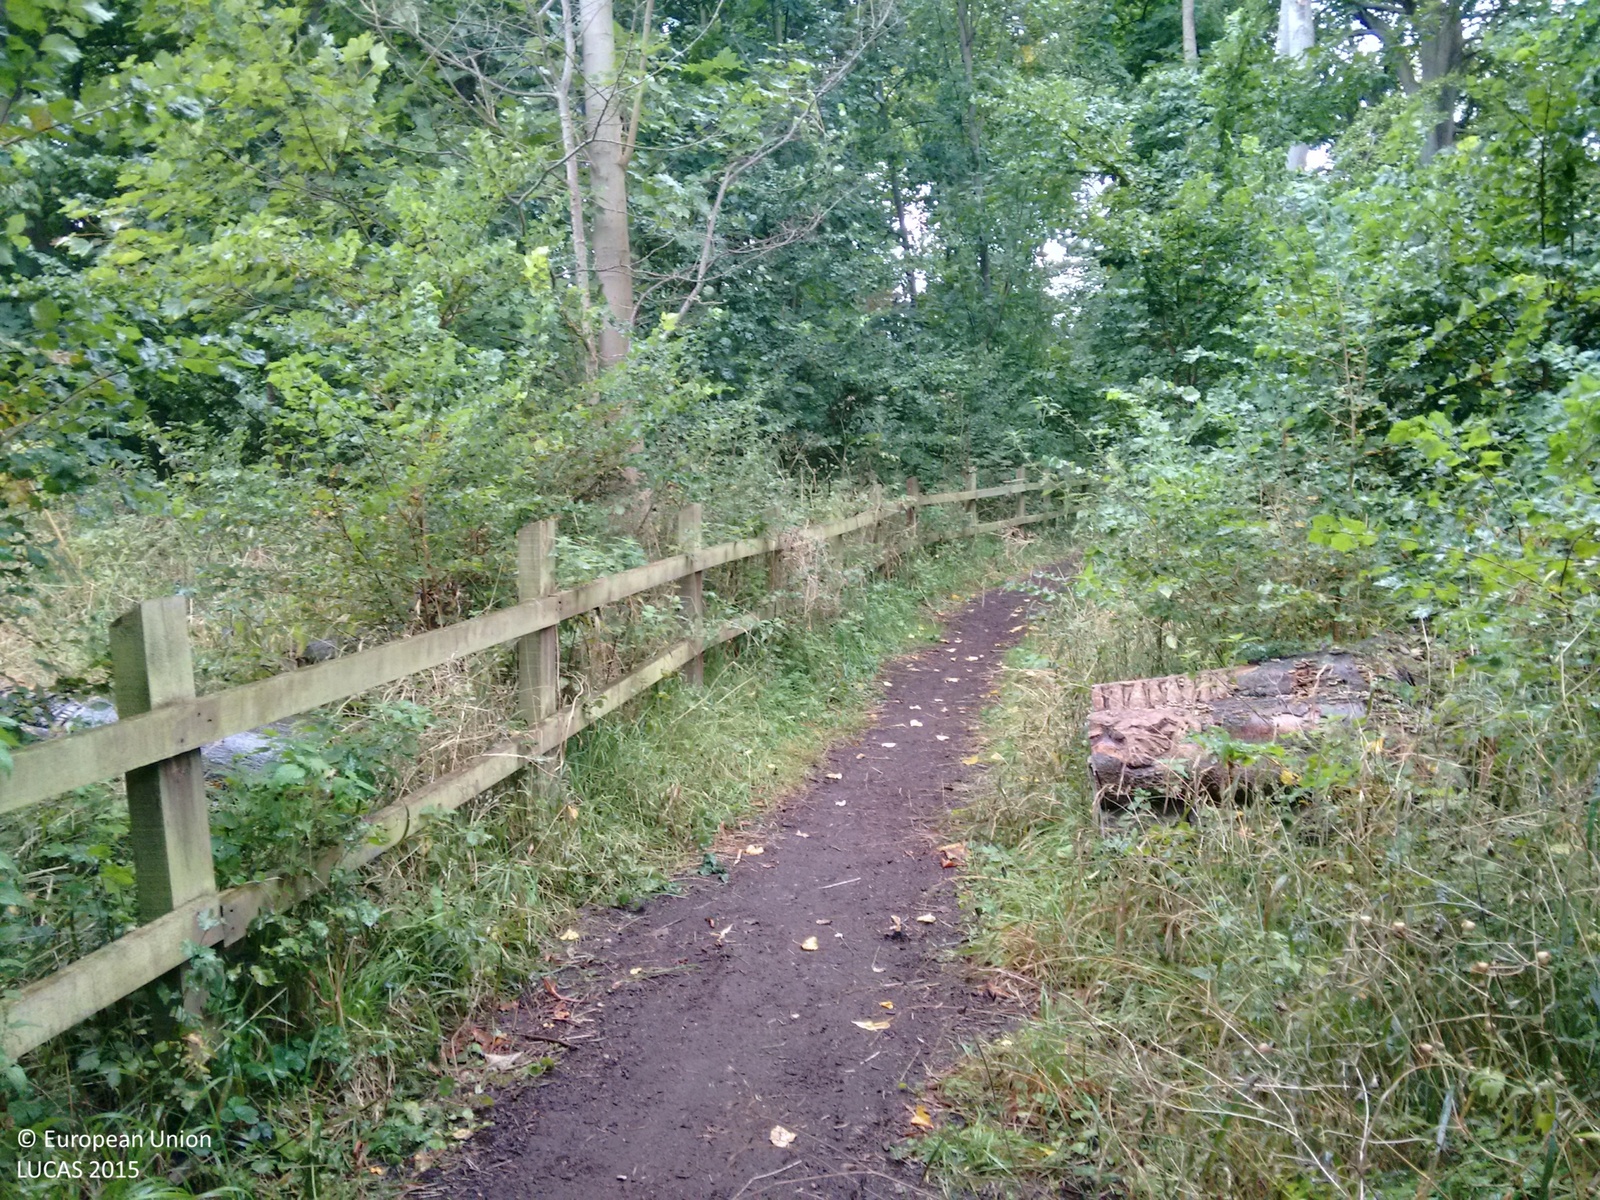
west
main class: Woodland
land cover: Broadleaved woodland
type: mesophytic deciduous forest
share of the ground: > 75 %
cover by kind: broadleaved forest trees 100 %
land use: Amenities, museums, leisure
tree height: > 5 m
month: September
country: GB
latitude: 52.6210
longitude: 1.3385
